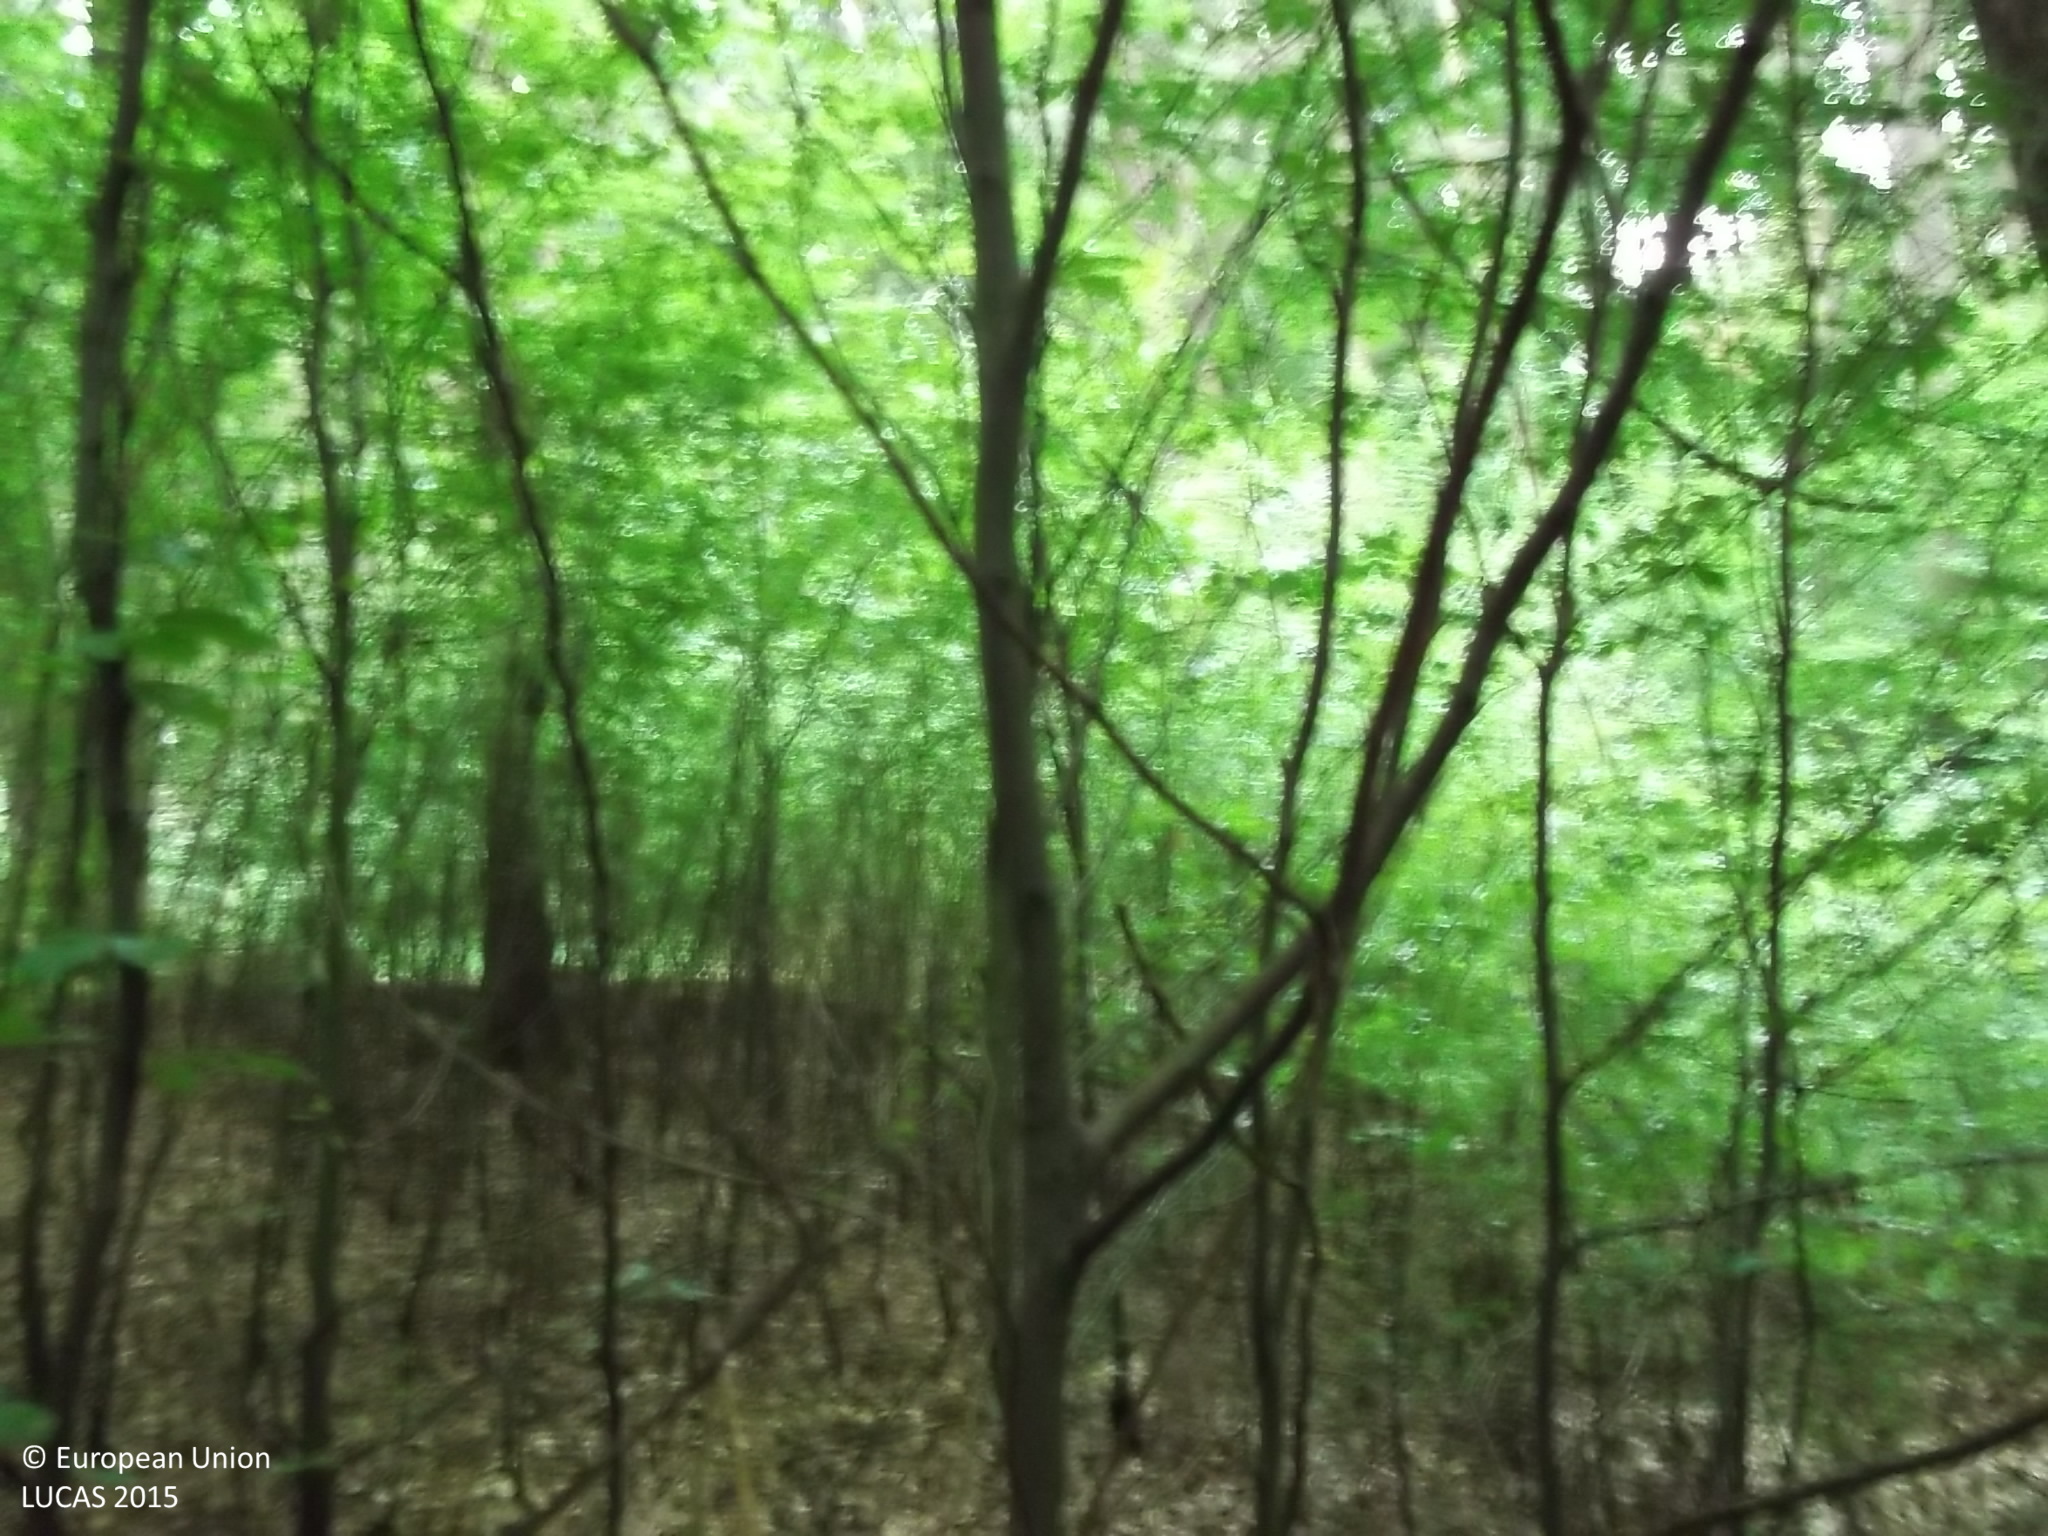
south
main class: Woodland
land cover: Other mixed woodland
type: hemiboreal forest and nemoral coniferous forest and mixed broadleaved-coniferous forest
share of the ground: > 75 %
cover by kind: broadleaved forest trees 55 %, coniferous forest trees 40 %, shrubs 5 %
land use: Forestry
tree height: > 5 m
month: July
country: AT
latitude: 48.1165
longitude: 12.7795
